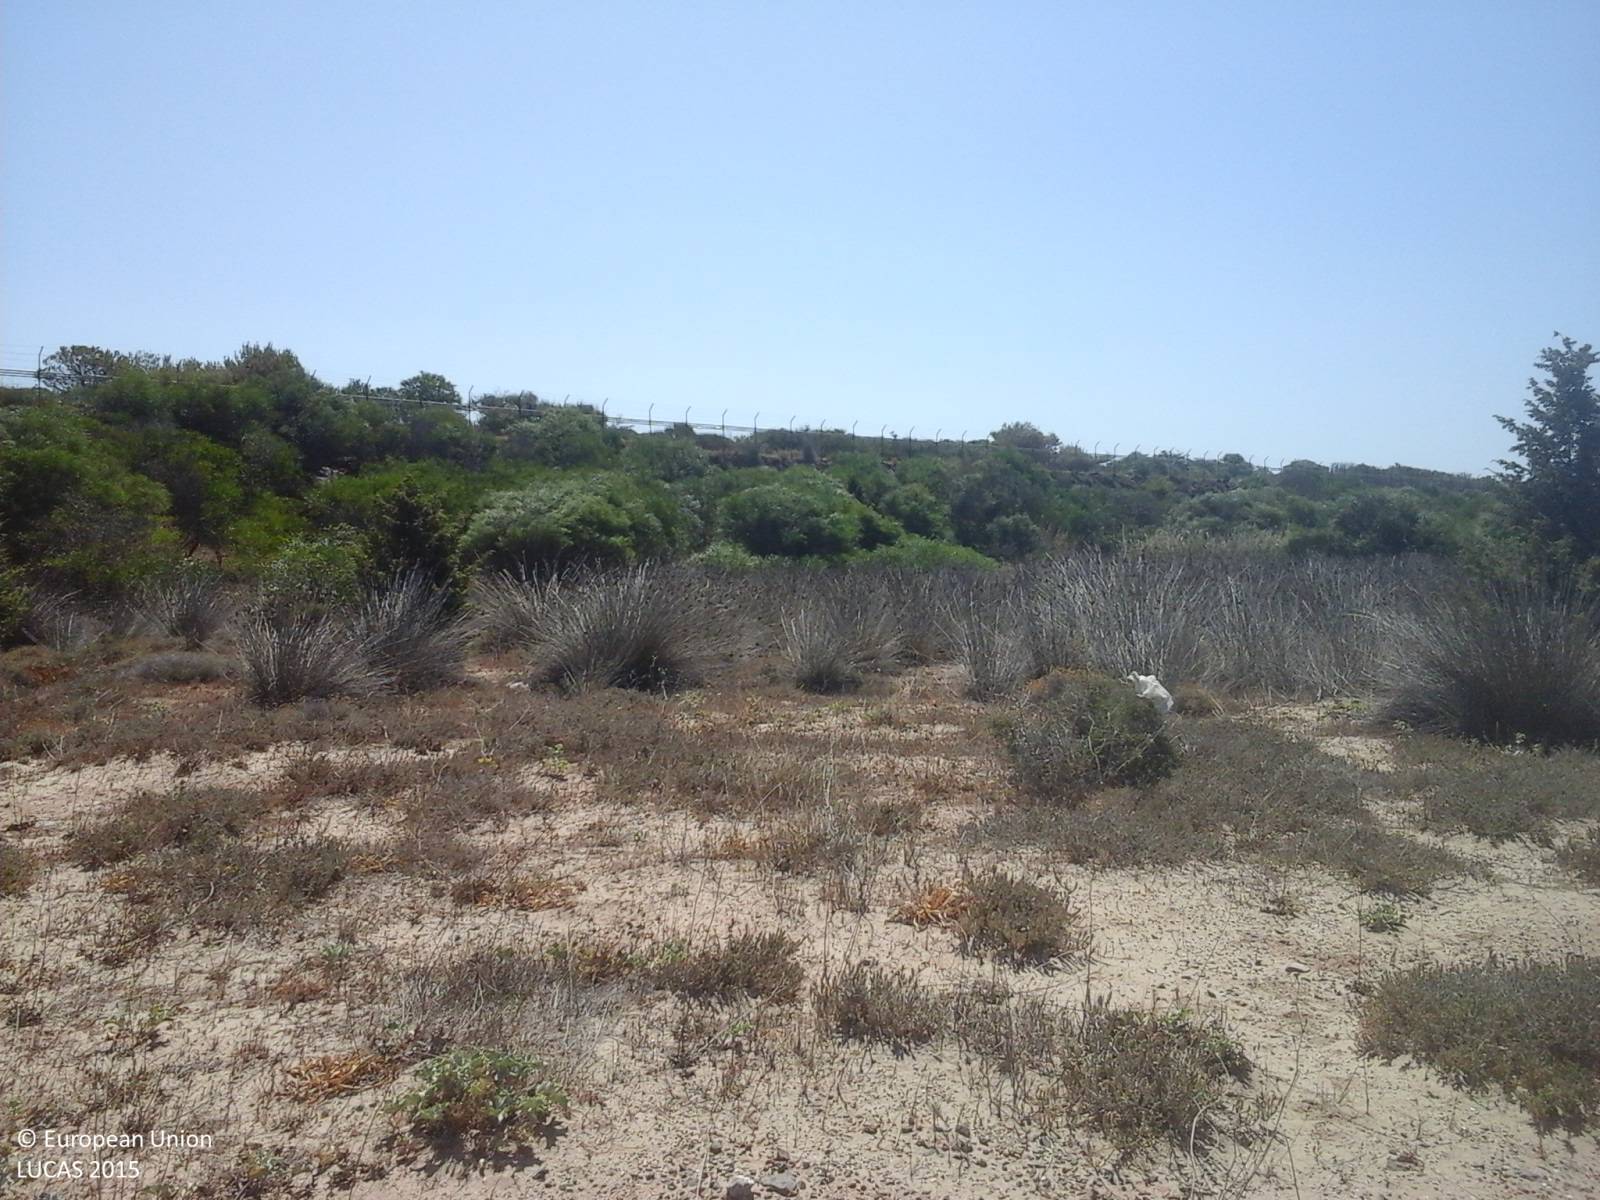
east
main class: Grassland
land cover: Grassland without tree/shrub cover
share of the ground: > 75 %
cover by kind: herbaceous plants 50 %, unconsolidated bare surface 45 %, consolidated bare surface 5 %
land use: Semi-natural and natural areas not in use
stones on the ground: < 10 %
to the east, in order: Grassland without tree/shrub cover; Shrubland without tree cover; Rocks and stones; Artificial constructions in urban areas
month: July
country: IT
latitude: 39.1855
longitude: 8.4007
